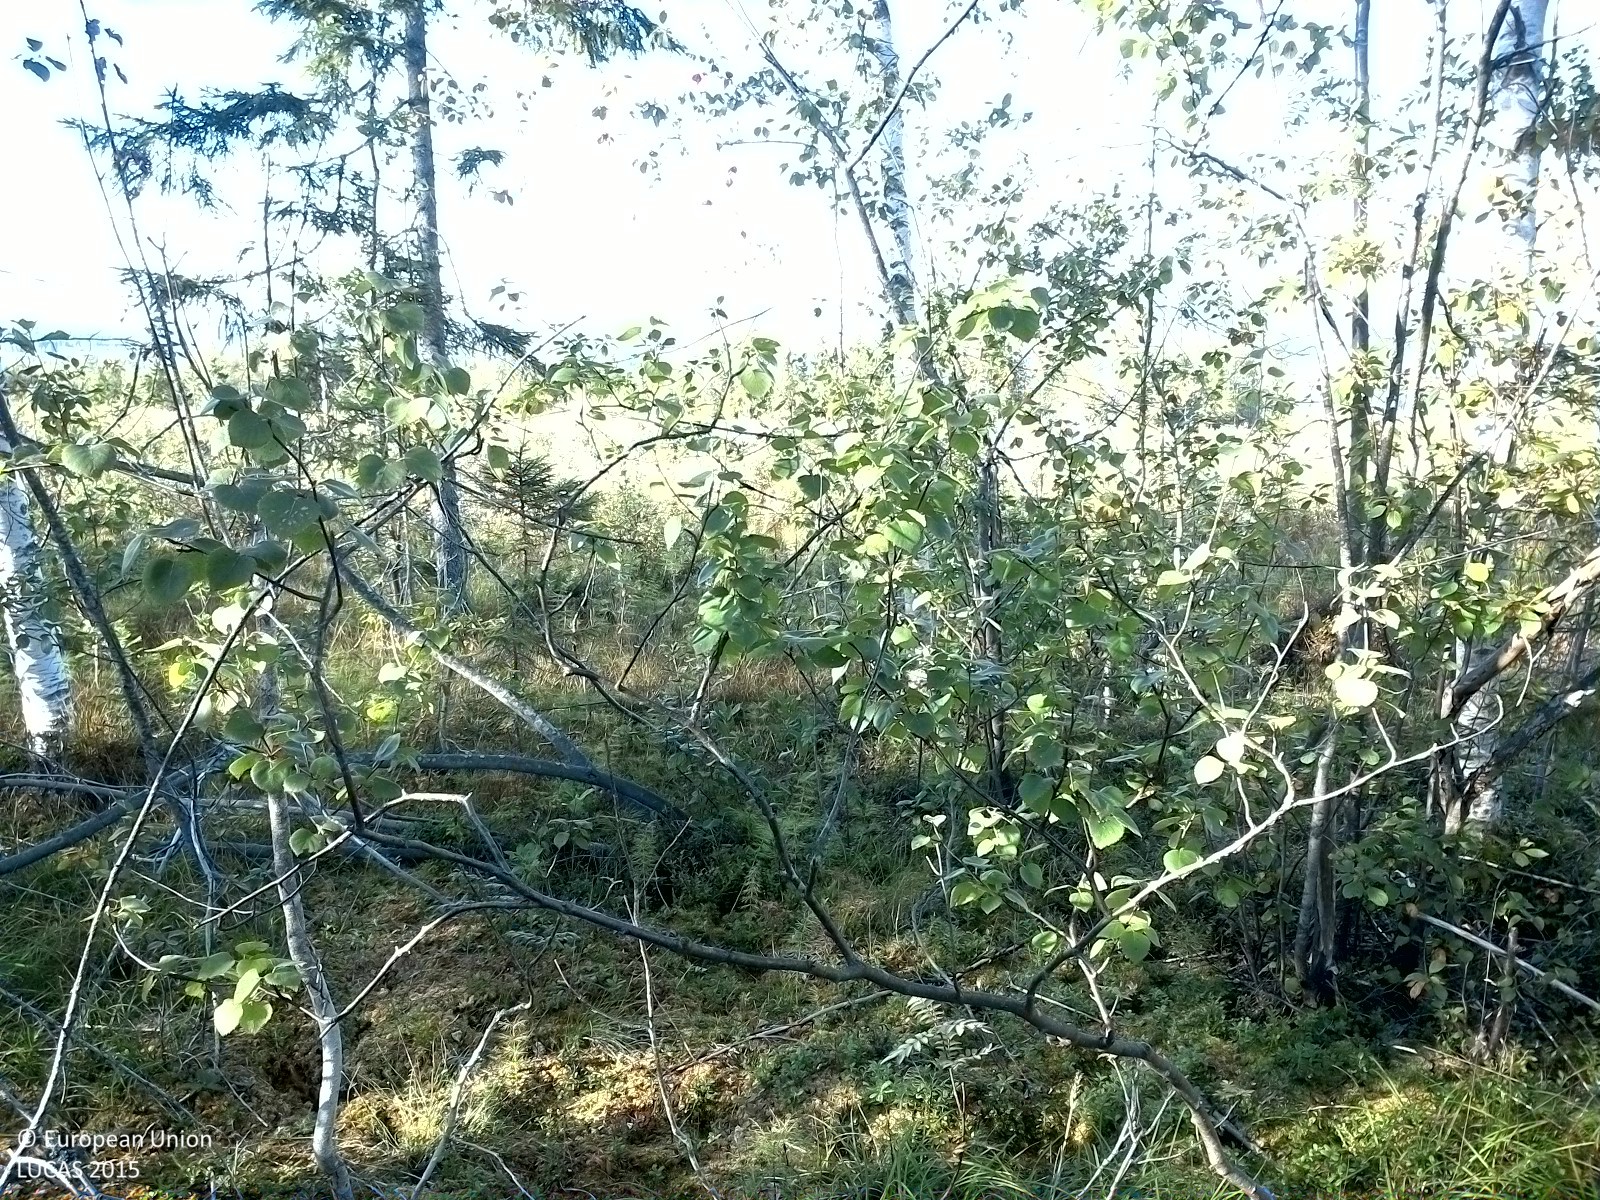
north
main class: Woodland
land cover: Other mixed woodland
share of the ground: 50 - 75 %
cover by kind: coniferous forest trees 30 %, broadleaved forest trees 20 %, herbaceous plants 20 %, lichens and mosses 20 %, shrubs 10 %
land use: Forestry
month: August
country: SE
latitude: 62.6058
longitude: 17.8704
